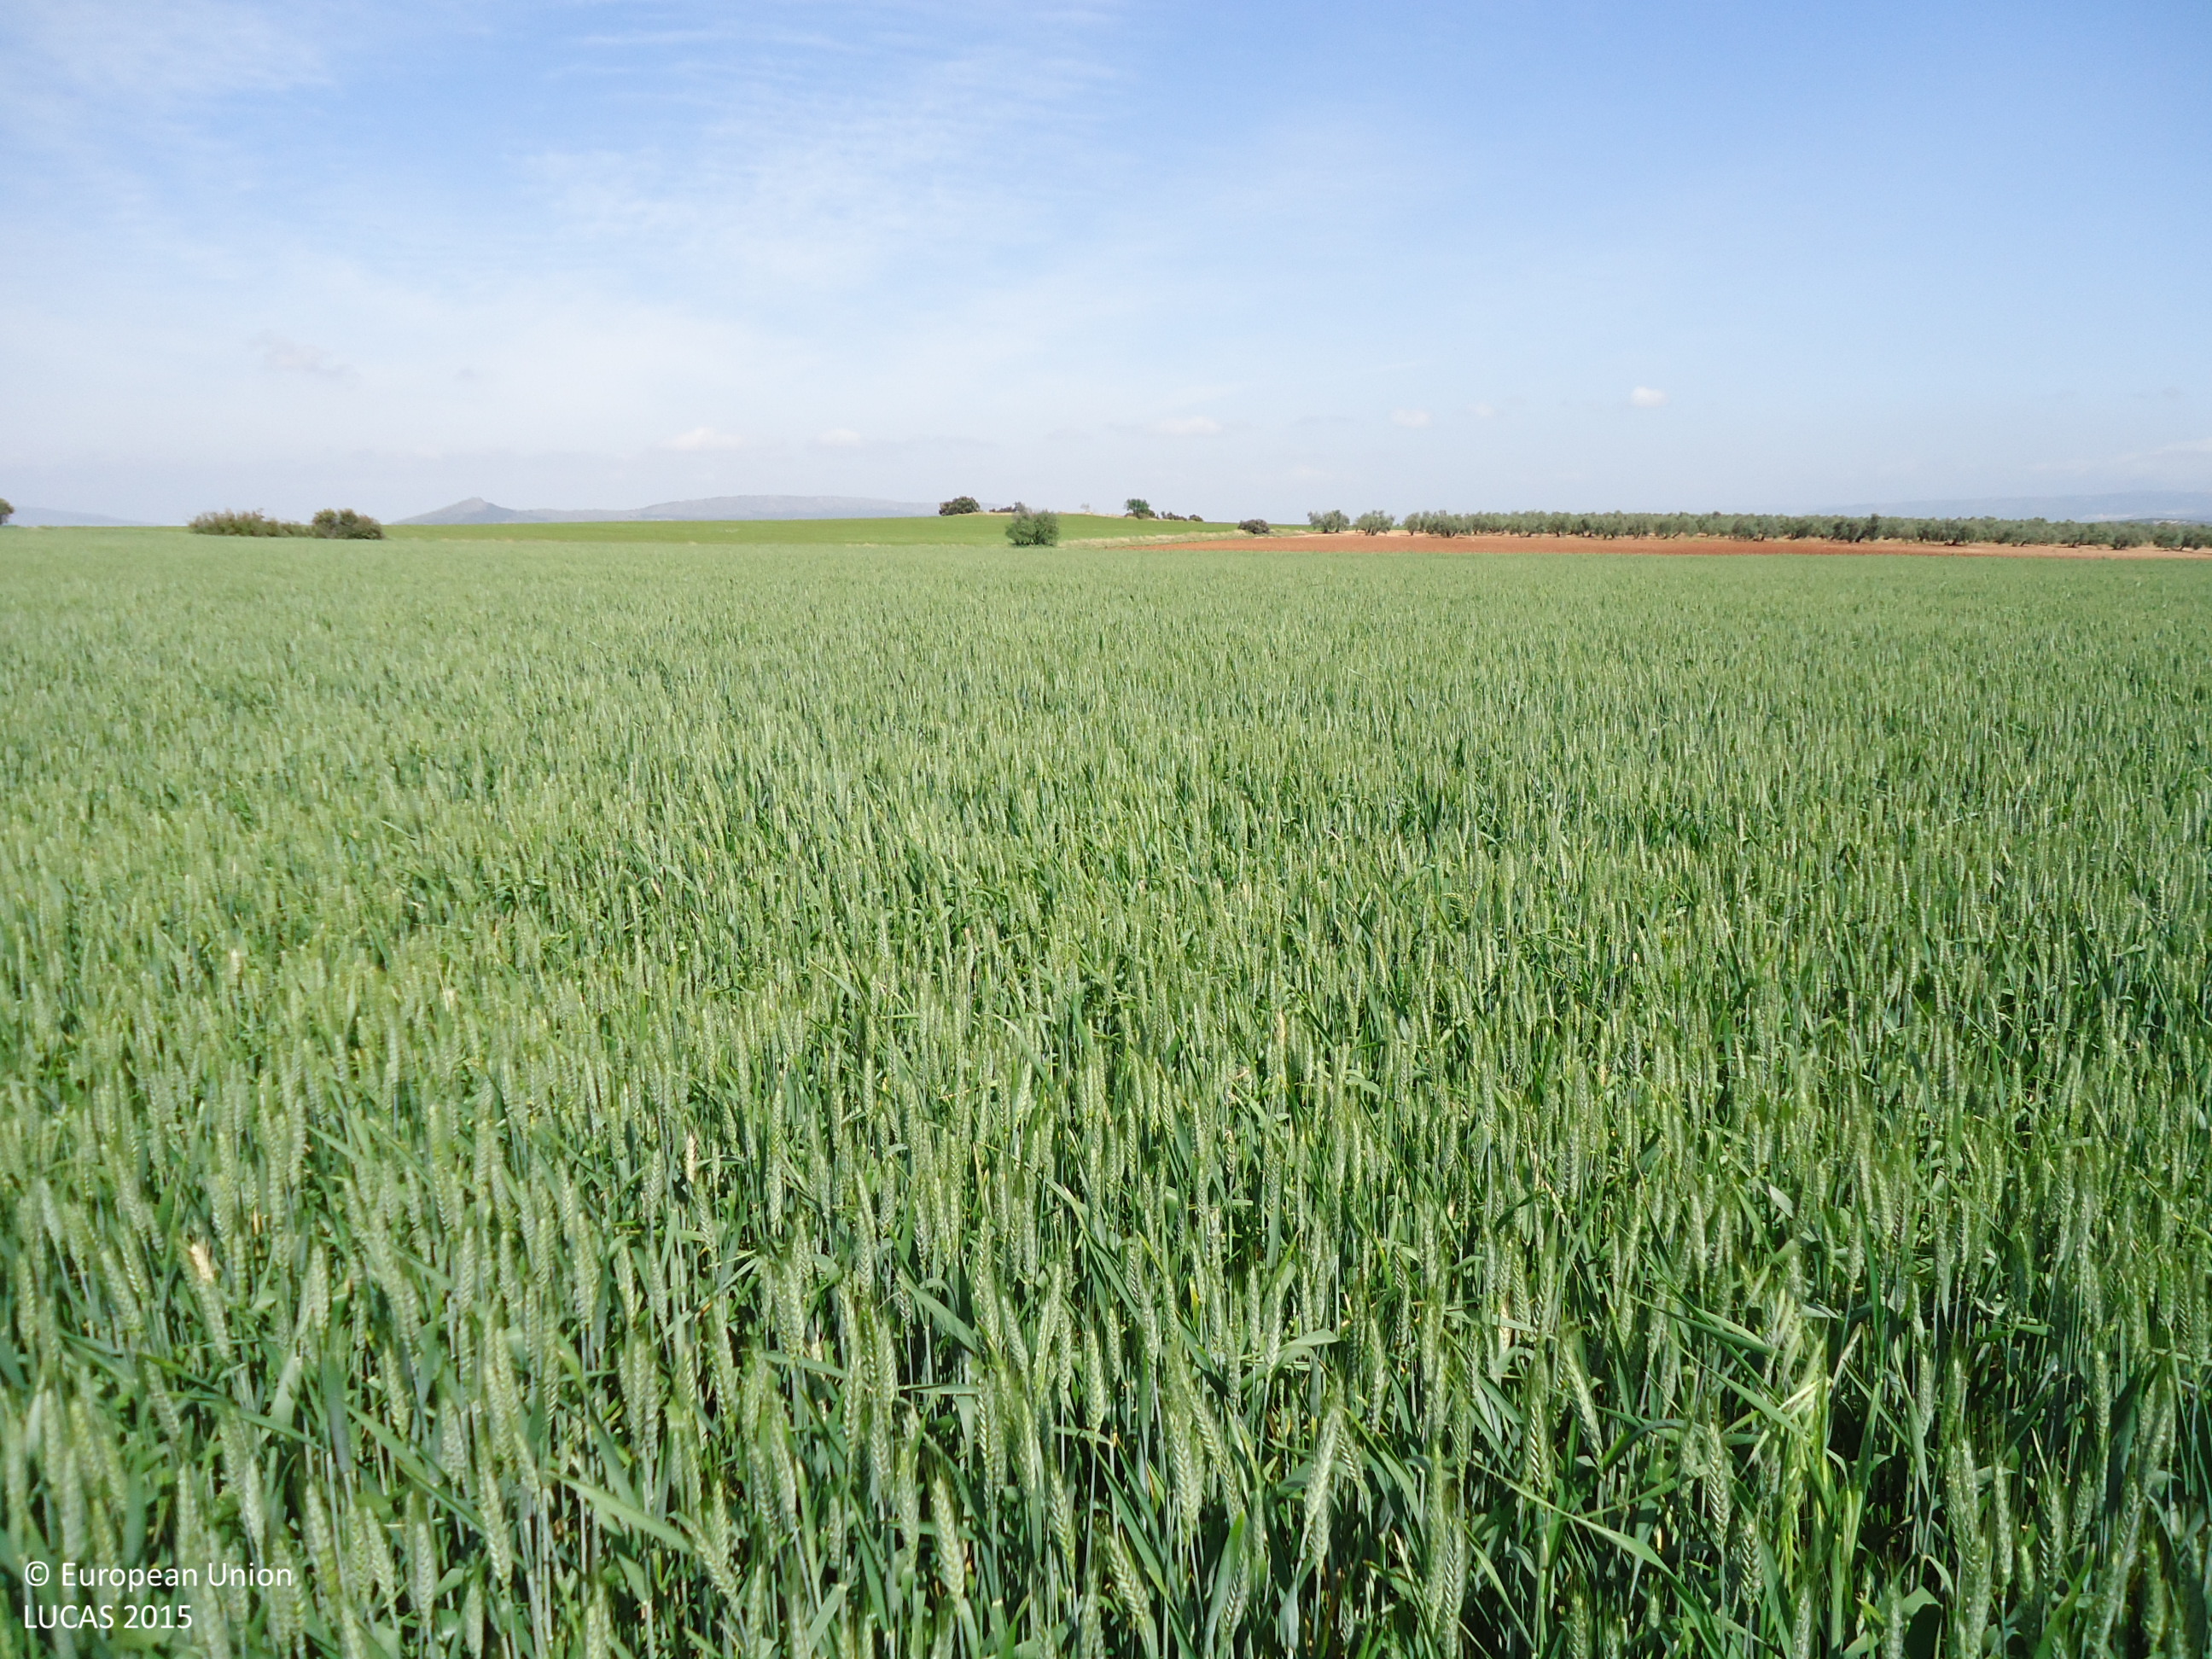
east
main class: Cropland
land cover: Common wheat
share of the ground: > 75 %
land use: Agriculture (excluding fallow land and kitchen gardens)
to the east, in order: Common wheat; Grass margins; Other bare soil
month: April
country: ES
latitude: 37.0627
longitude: -4.7891
